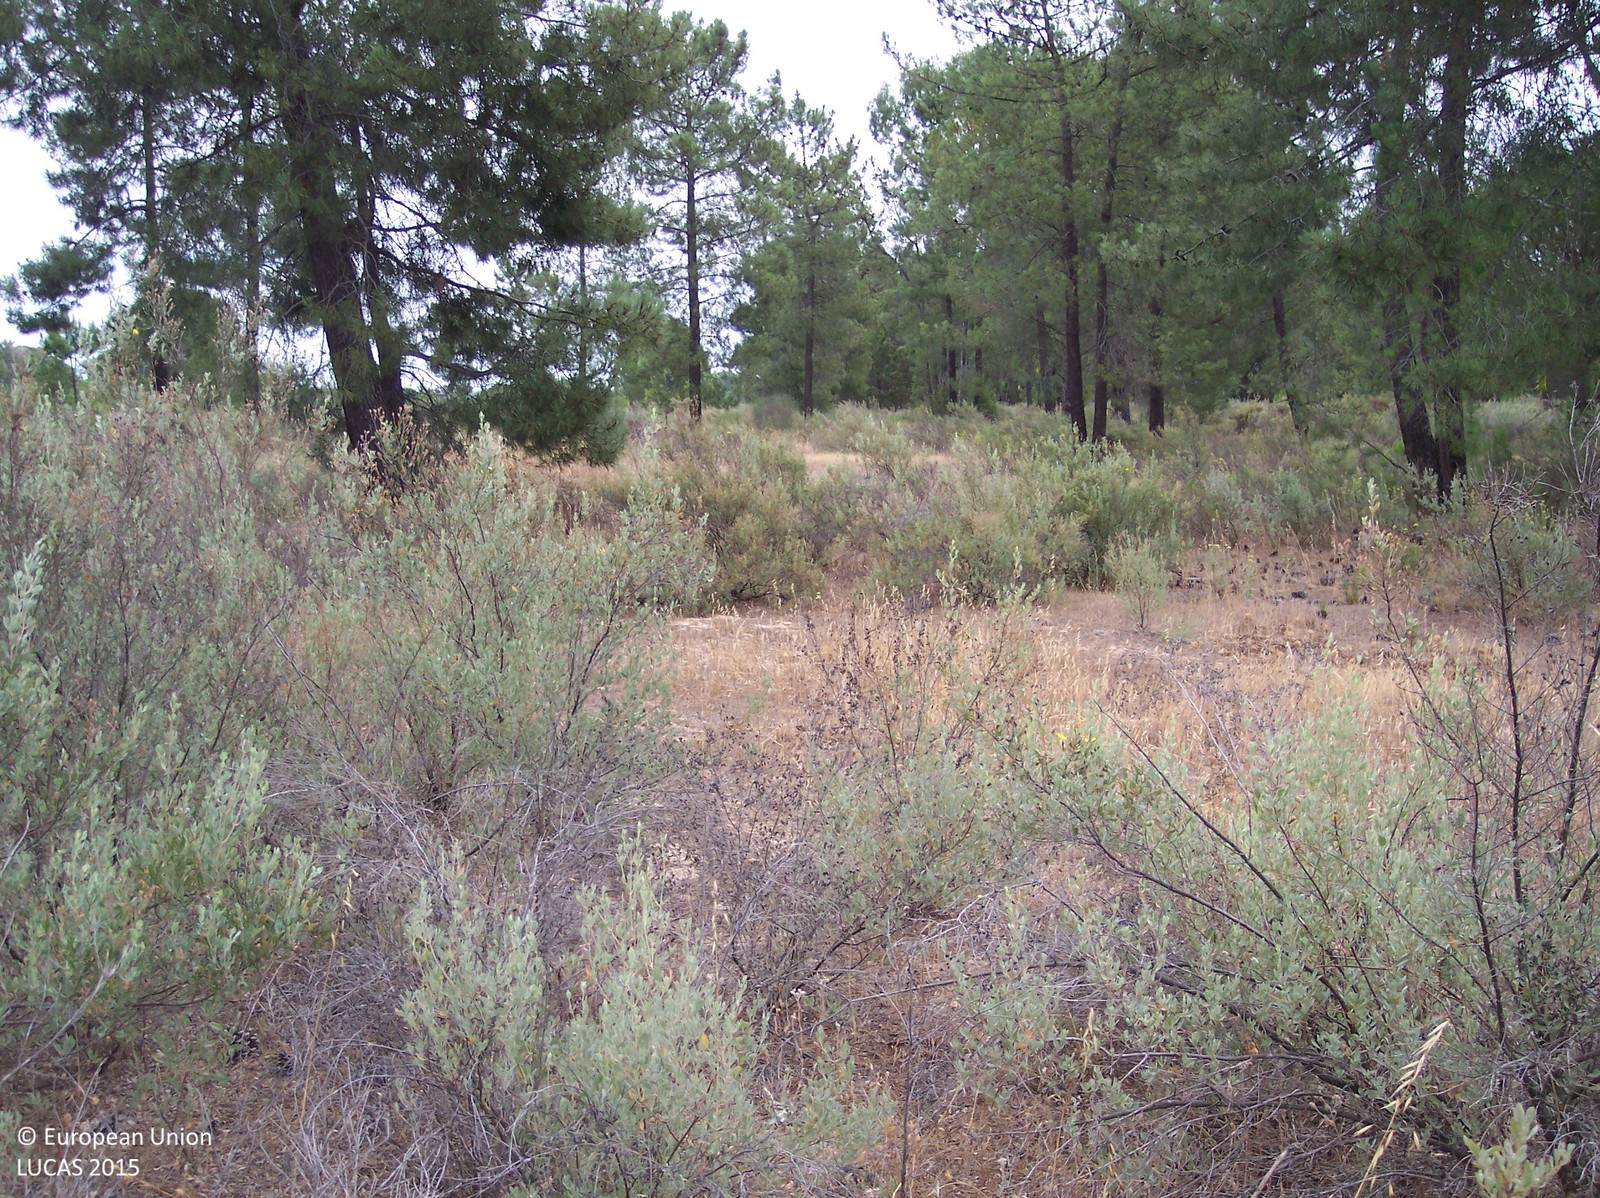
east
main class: Shrubland
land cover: Shrubland with sparse tree cover
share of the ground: > 75 %
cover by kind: shrubs 70 %, herbaceous plants 25 %, coniferous forest trees 5 %
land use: Semi-natural and natural areas not in use
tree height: > 5 m
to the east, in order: Shrubland with sparse tree cover; Pine dominated coniferous woodland; Shrubland with sparse tree cover
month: June
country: ES
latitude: 37.3196
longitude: -6.4490
